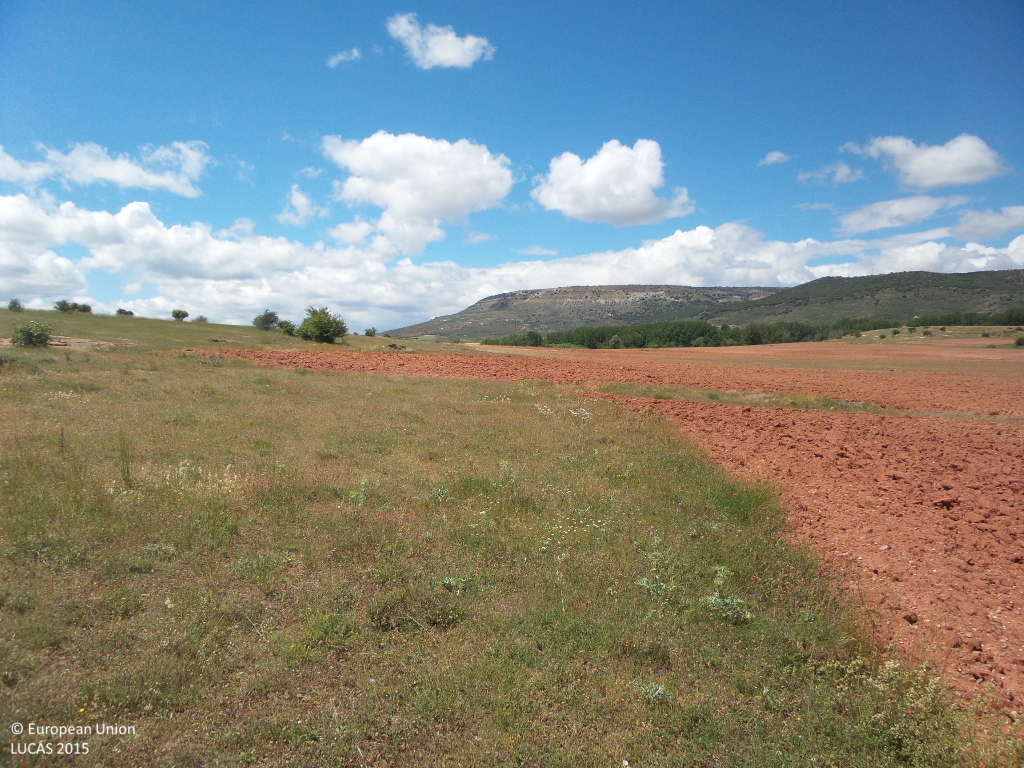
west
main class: Grassland
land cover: Spontaneously vegetated surfaces
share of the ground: > 75 %
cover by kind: herbaceous plants 95 %, shrubs 5 %
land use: Semi-natural and natural areas not in use
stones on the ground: < 10 %
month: June
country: ES
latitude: 41.2476
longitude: -2.9860
